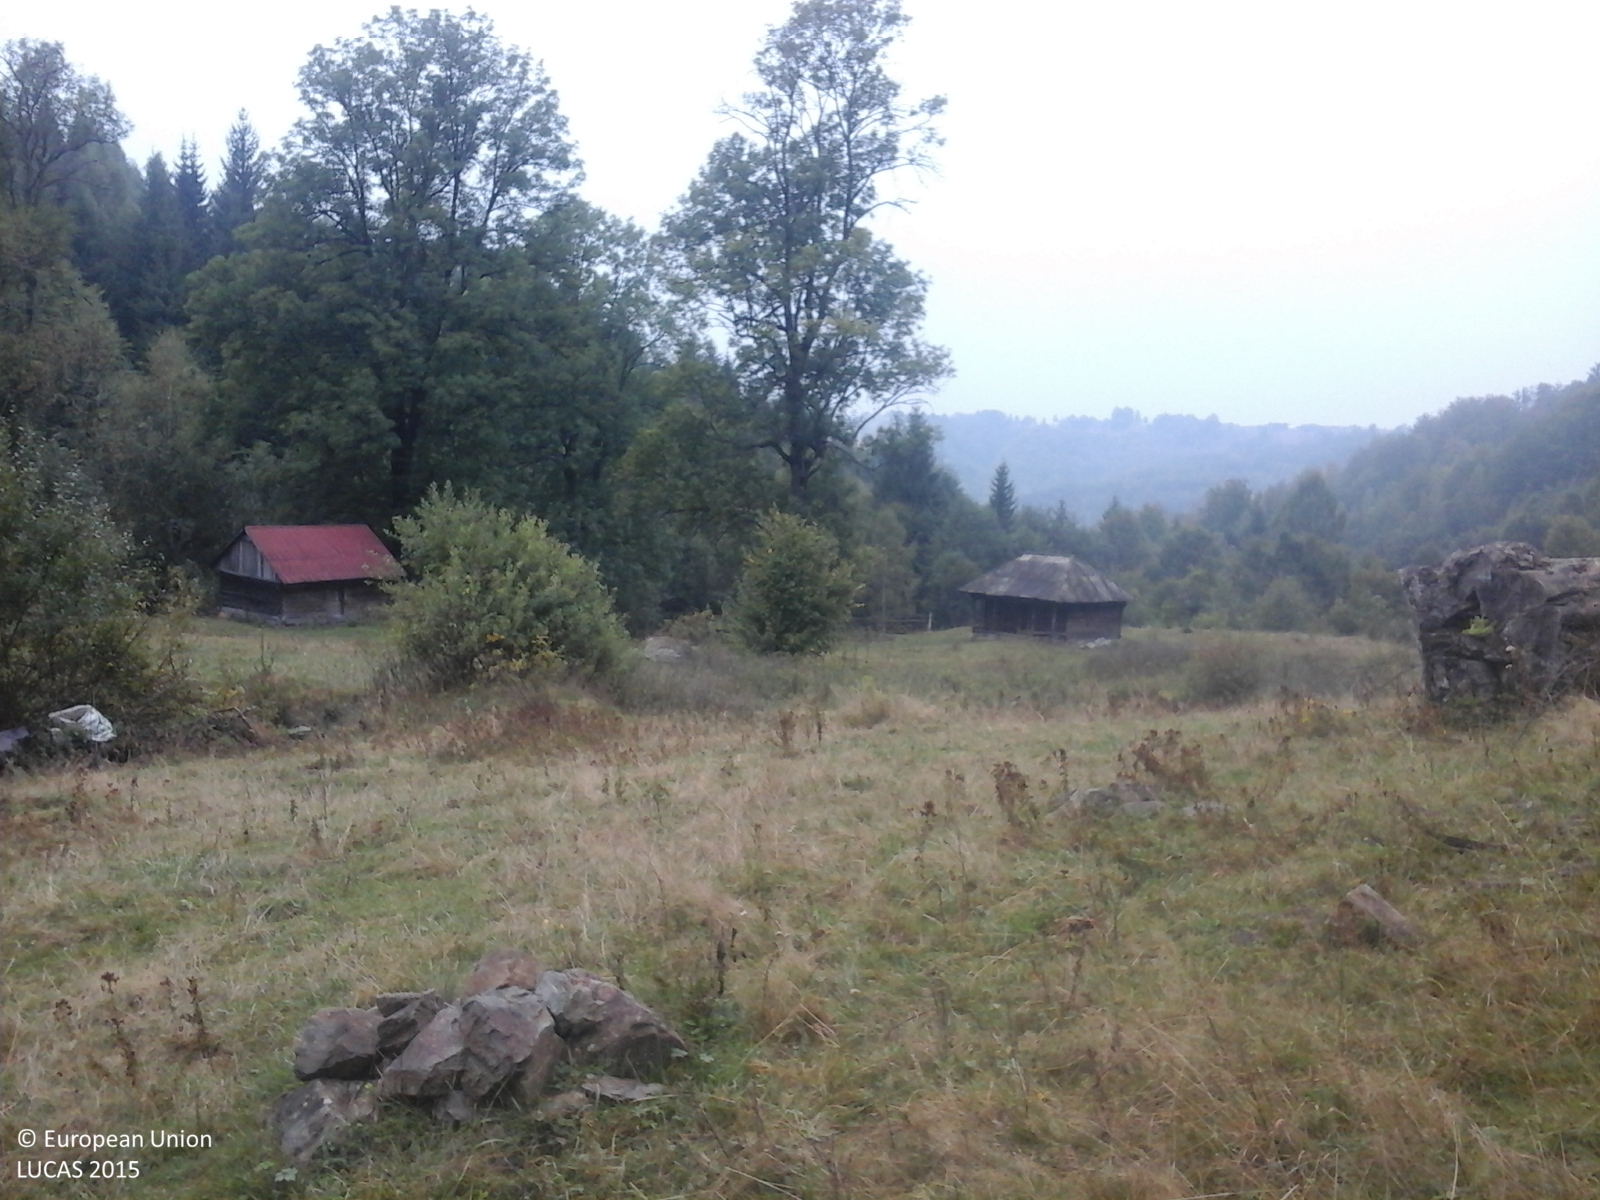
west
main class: Grassland
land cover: Grassland without tree/shrub cover
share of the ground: > 75 %
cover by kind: herbaceous plants 100 %
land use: Agriculture (excluding fallow land and kitchen gardens)
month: September
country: RO
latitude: 45.3690
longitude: 23.4530
